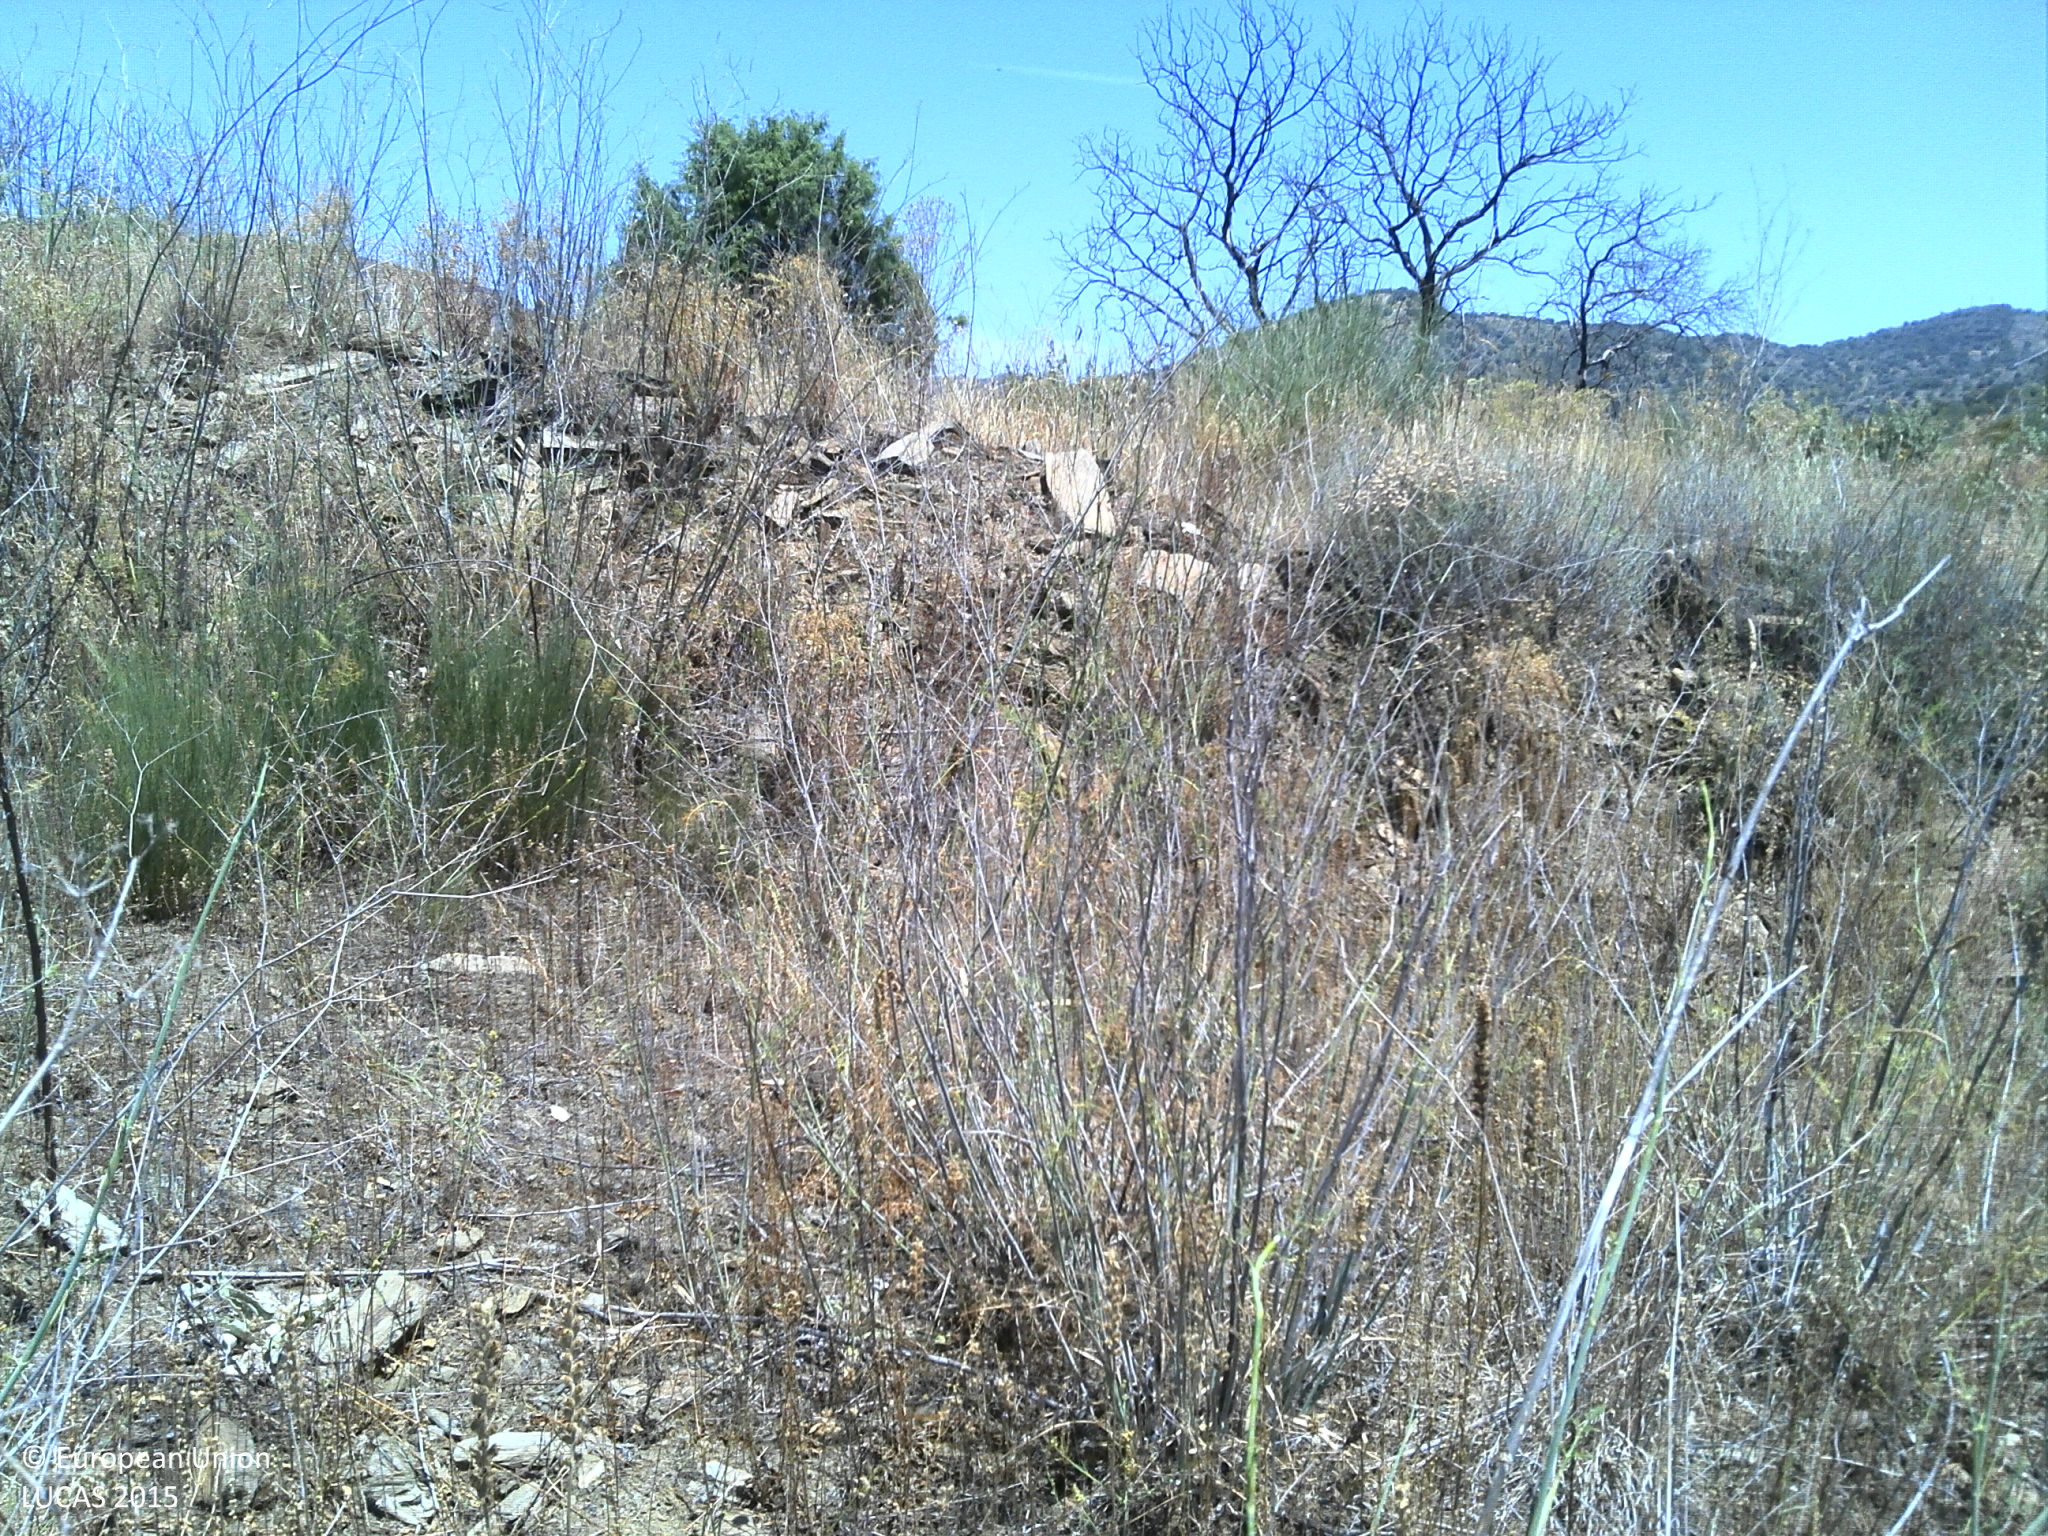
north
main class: Grassland
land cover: Spontaneously vegetated surfaces
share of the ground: > 75 %
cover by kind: herbaceous plants 95 %, unconsolidated bare surface 5 %
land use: Fallow land
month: June
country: PT
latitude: 41.0138
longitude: -6.9311
